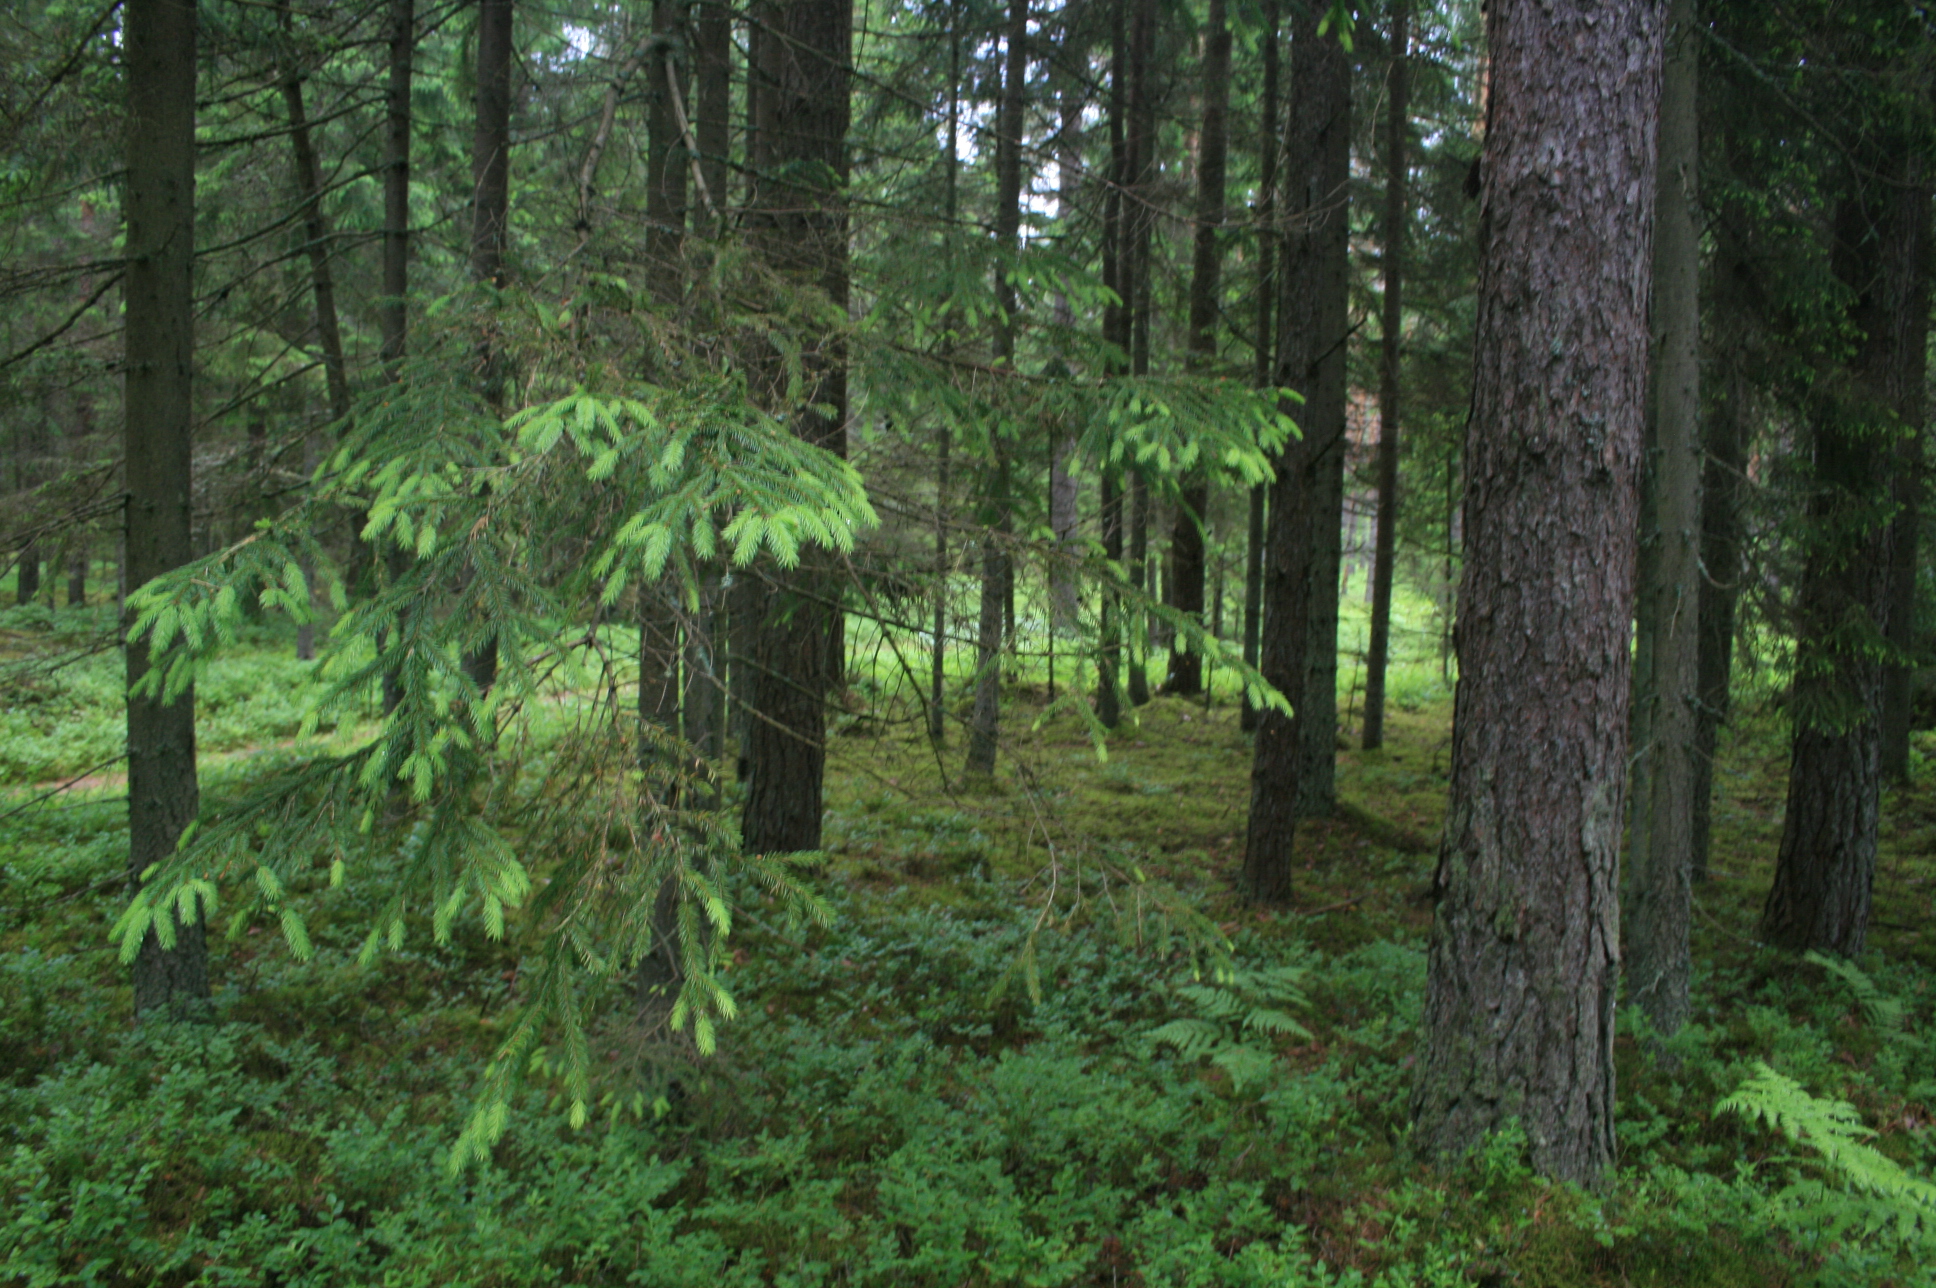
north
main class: Woodland
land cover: Other coniferous woodland
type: hemiboreal forest and nemoral coniferous forest and mixed broadleaved-coniferous forest
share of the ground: > 75 %
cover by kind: coniferous forest trees 85 %, shrubs 5 %, herbaceous plants 5 %, lichens and mosses 5 %
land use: Forestry
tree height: > 5 m
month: June
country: LT
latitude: 55.0925
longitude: 22.3921
